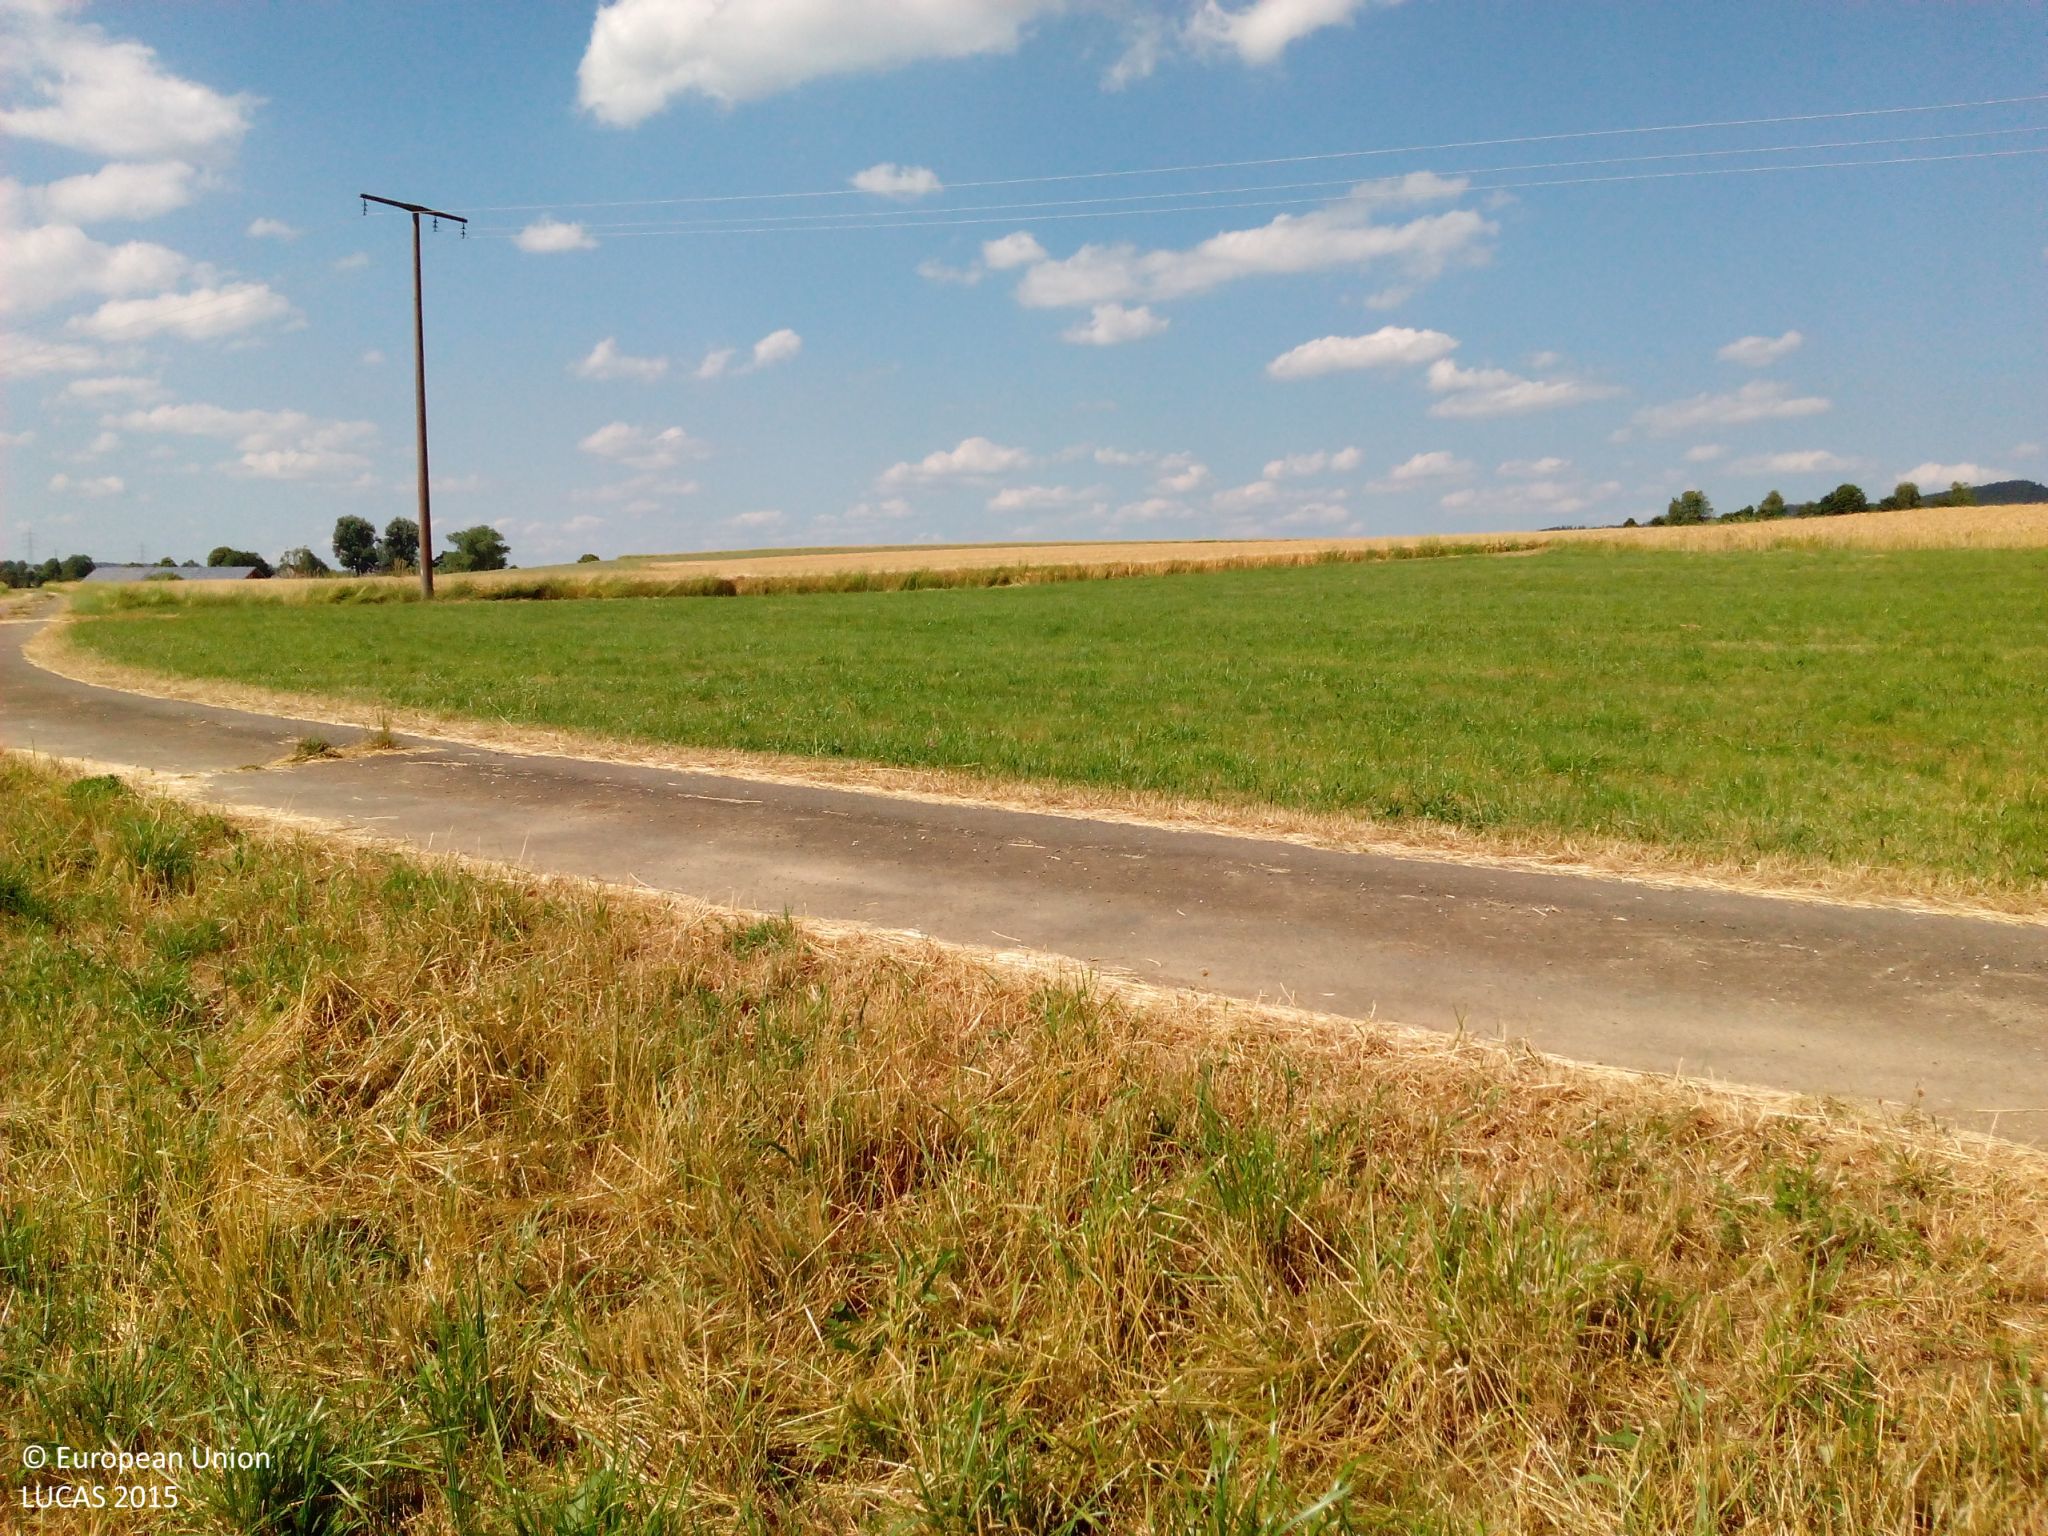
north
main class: Grassland
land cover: Grassland without tree/shrub cover
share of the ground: > 75 %
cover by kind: herbaceous plants 100 %
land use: Agriculture (excluding fallow land and kitchen gardens)
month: July
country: DE
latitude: 47.9806
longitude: 8.5942
